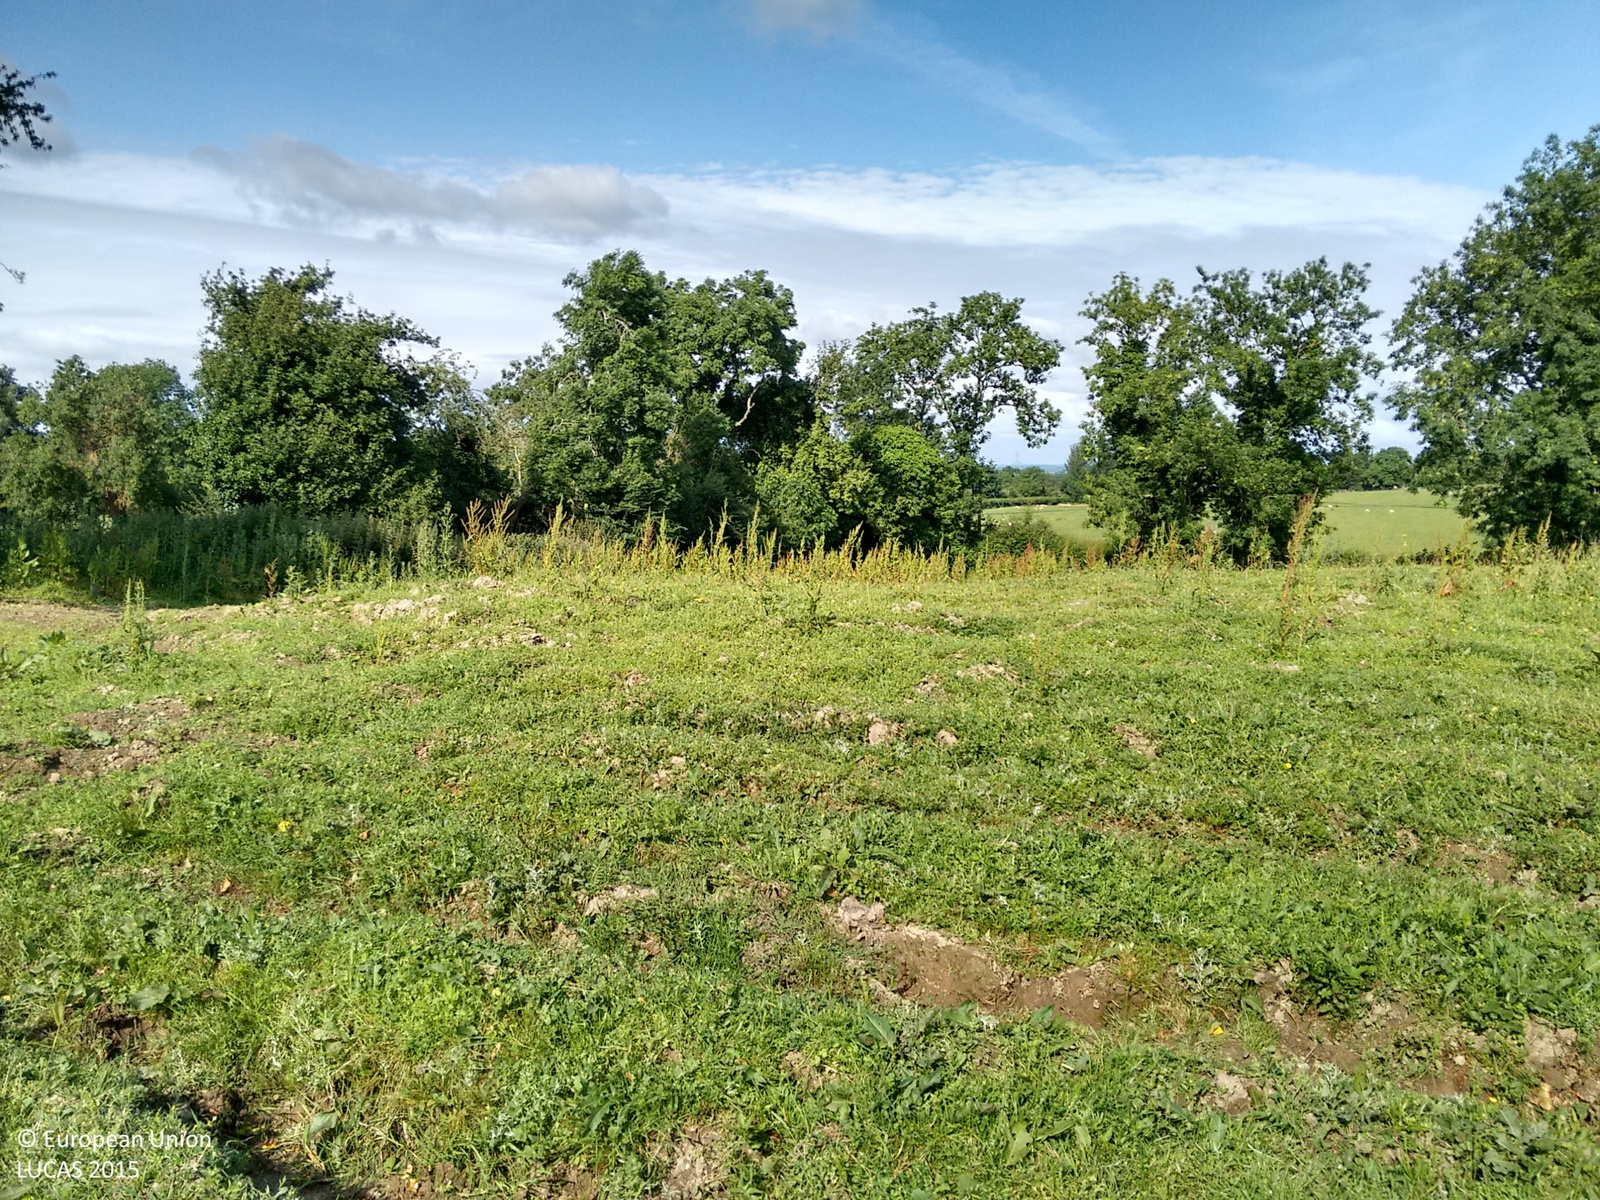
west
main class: Grassland
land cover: Grassland without tree/shrub cover
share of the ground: > 75 %
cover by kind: herbaceous plants 100 %
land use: Agriculture (excluding fallow land and kitchen gardens)
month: July
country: IE
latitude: 53.1637
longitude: -6.5980
